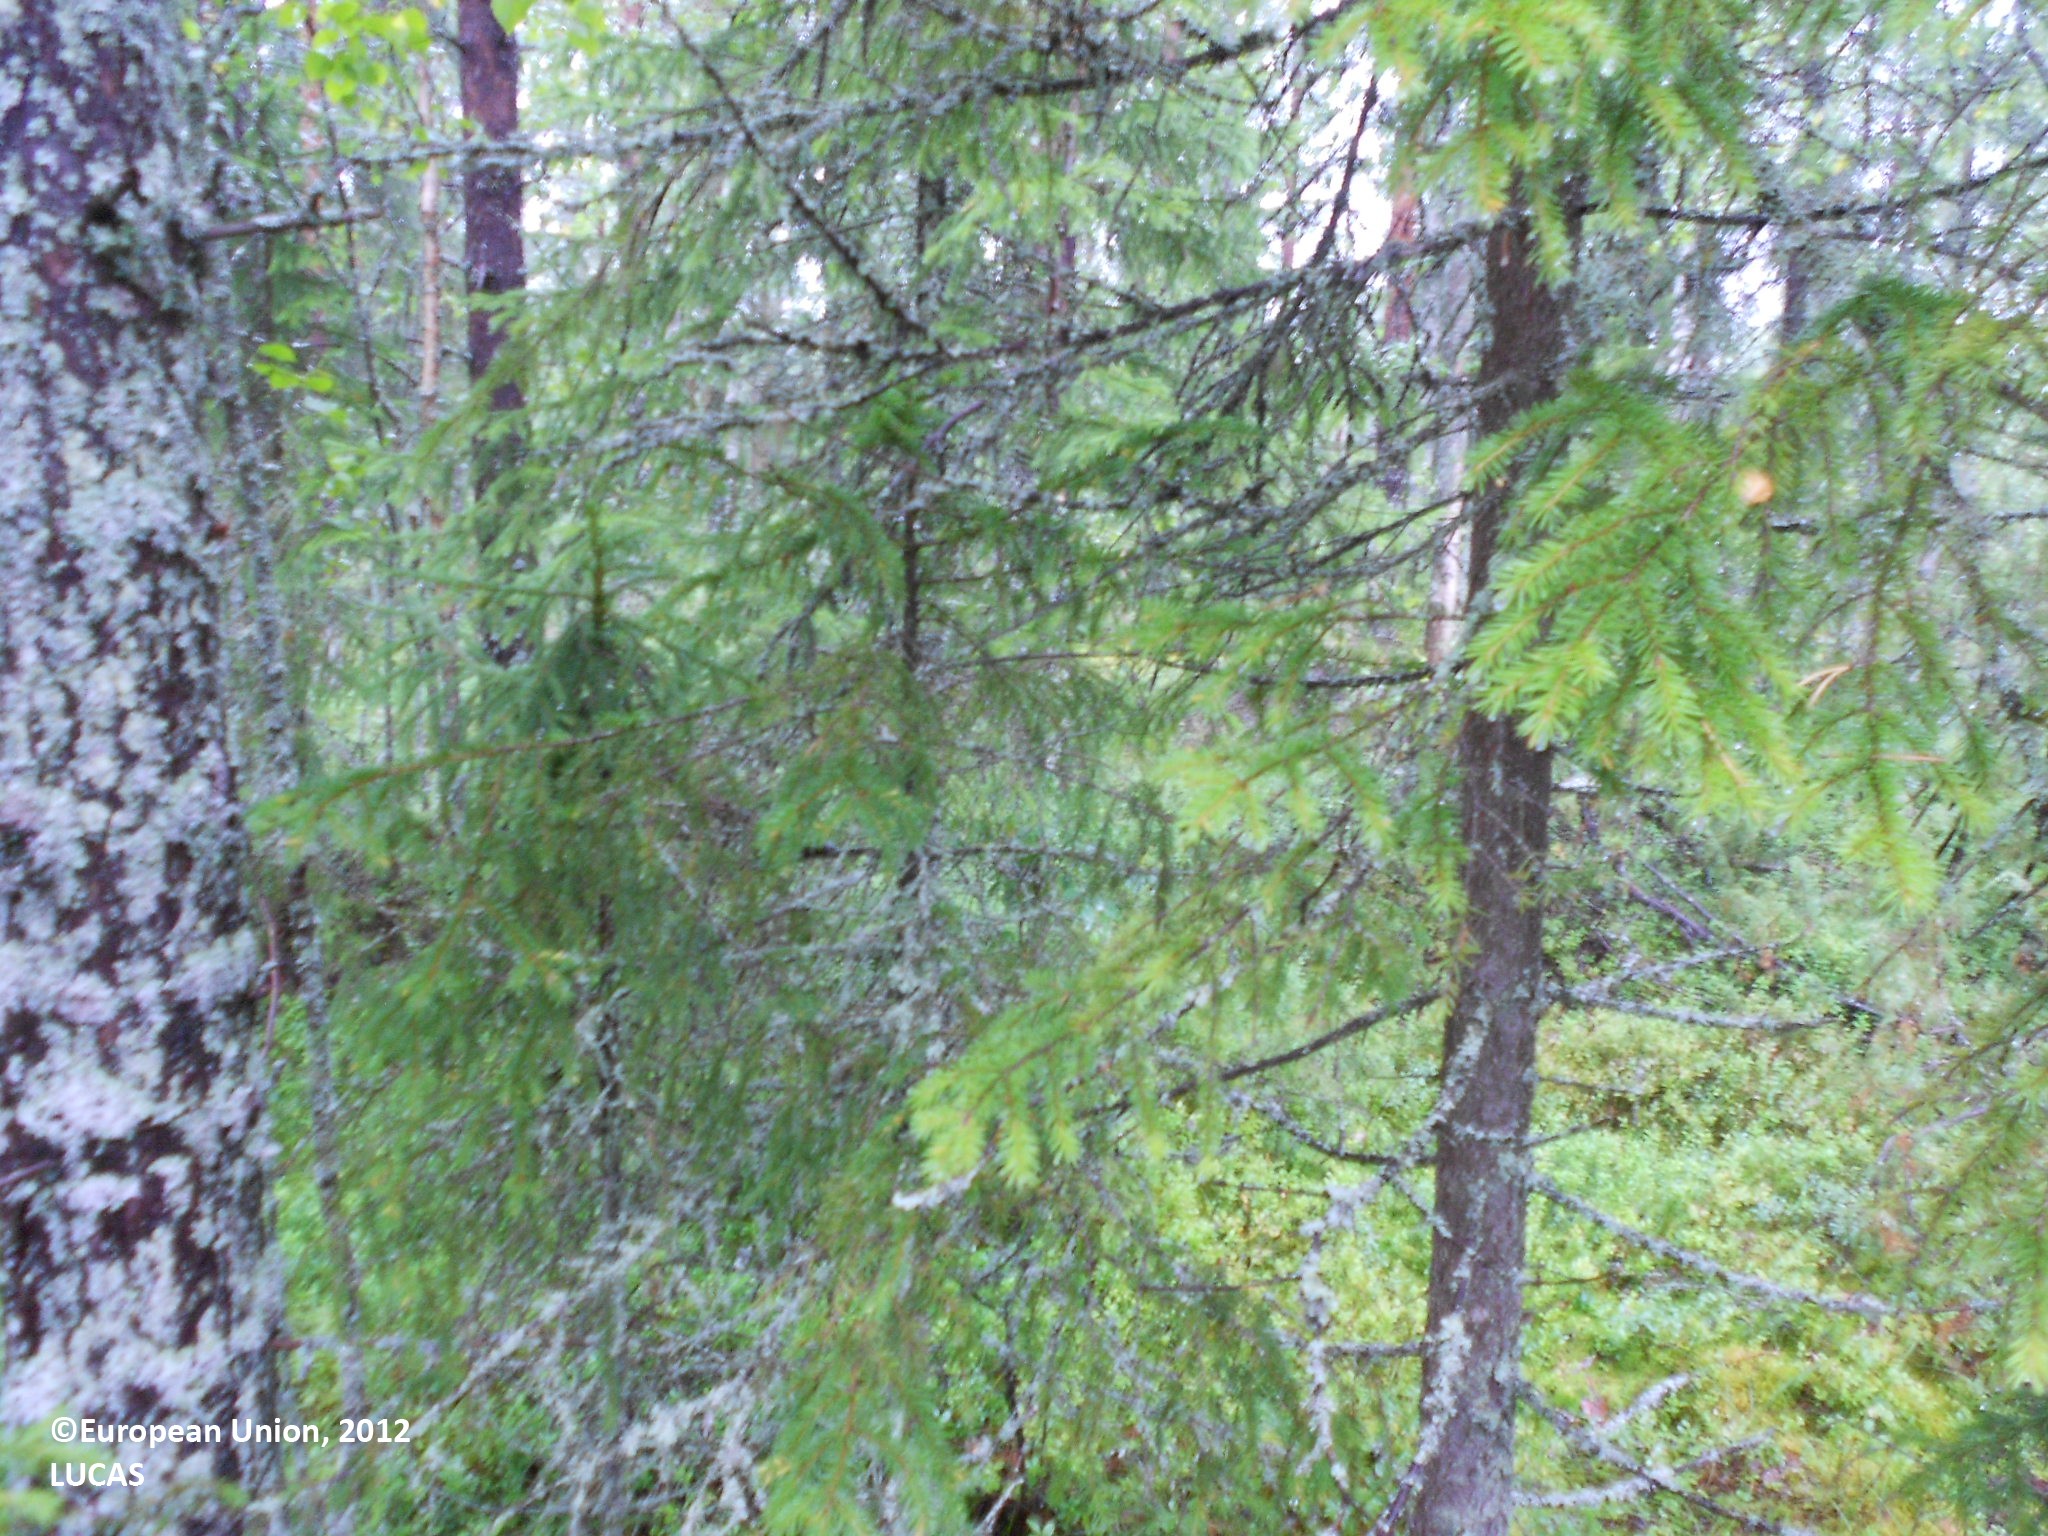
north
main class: Woodland
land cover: Pine dominated mixed woodland
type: boreal forest
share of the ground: 50 - 75 %
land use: Forestry
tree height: > 5 m
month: August
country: FI
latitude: 63.9250
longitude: 28.2203
